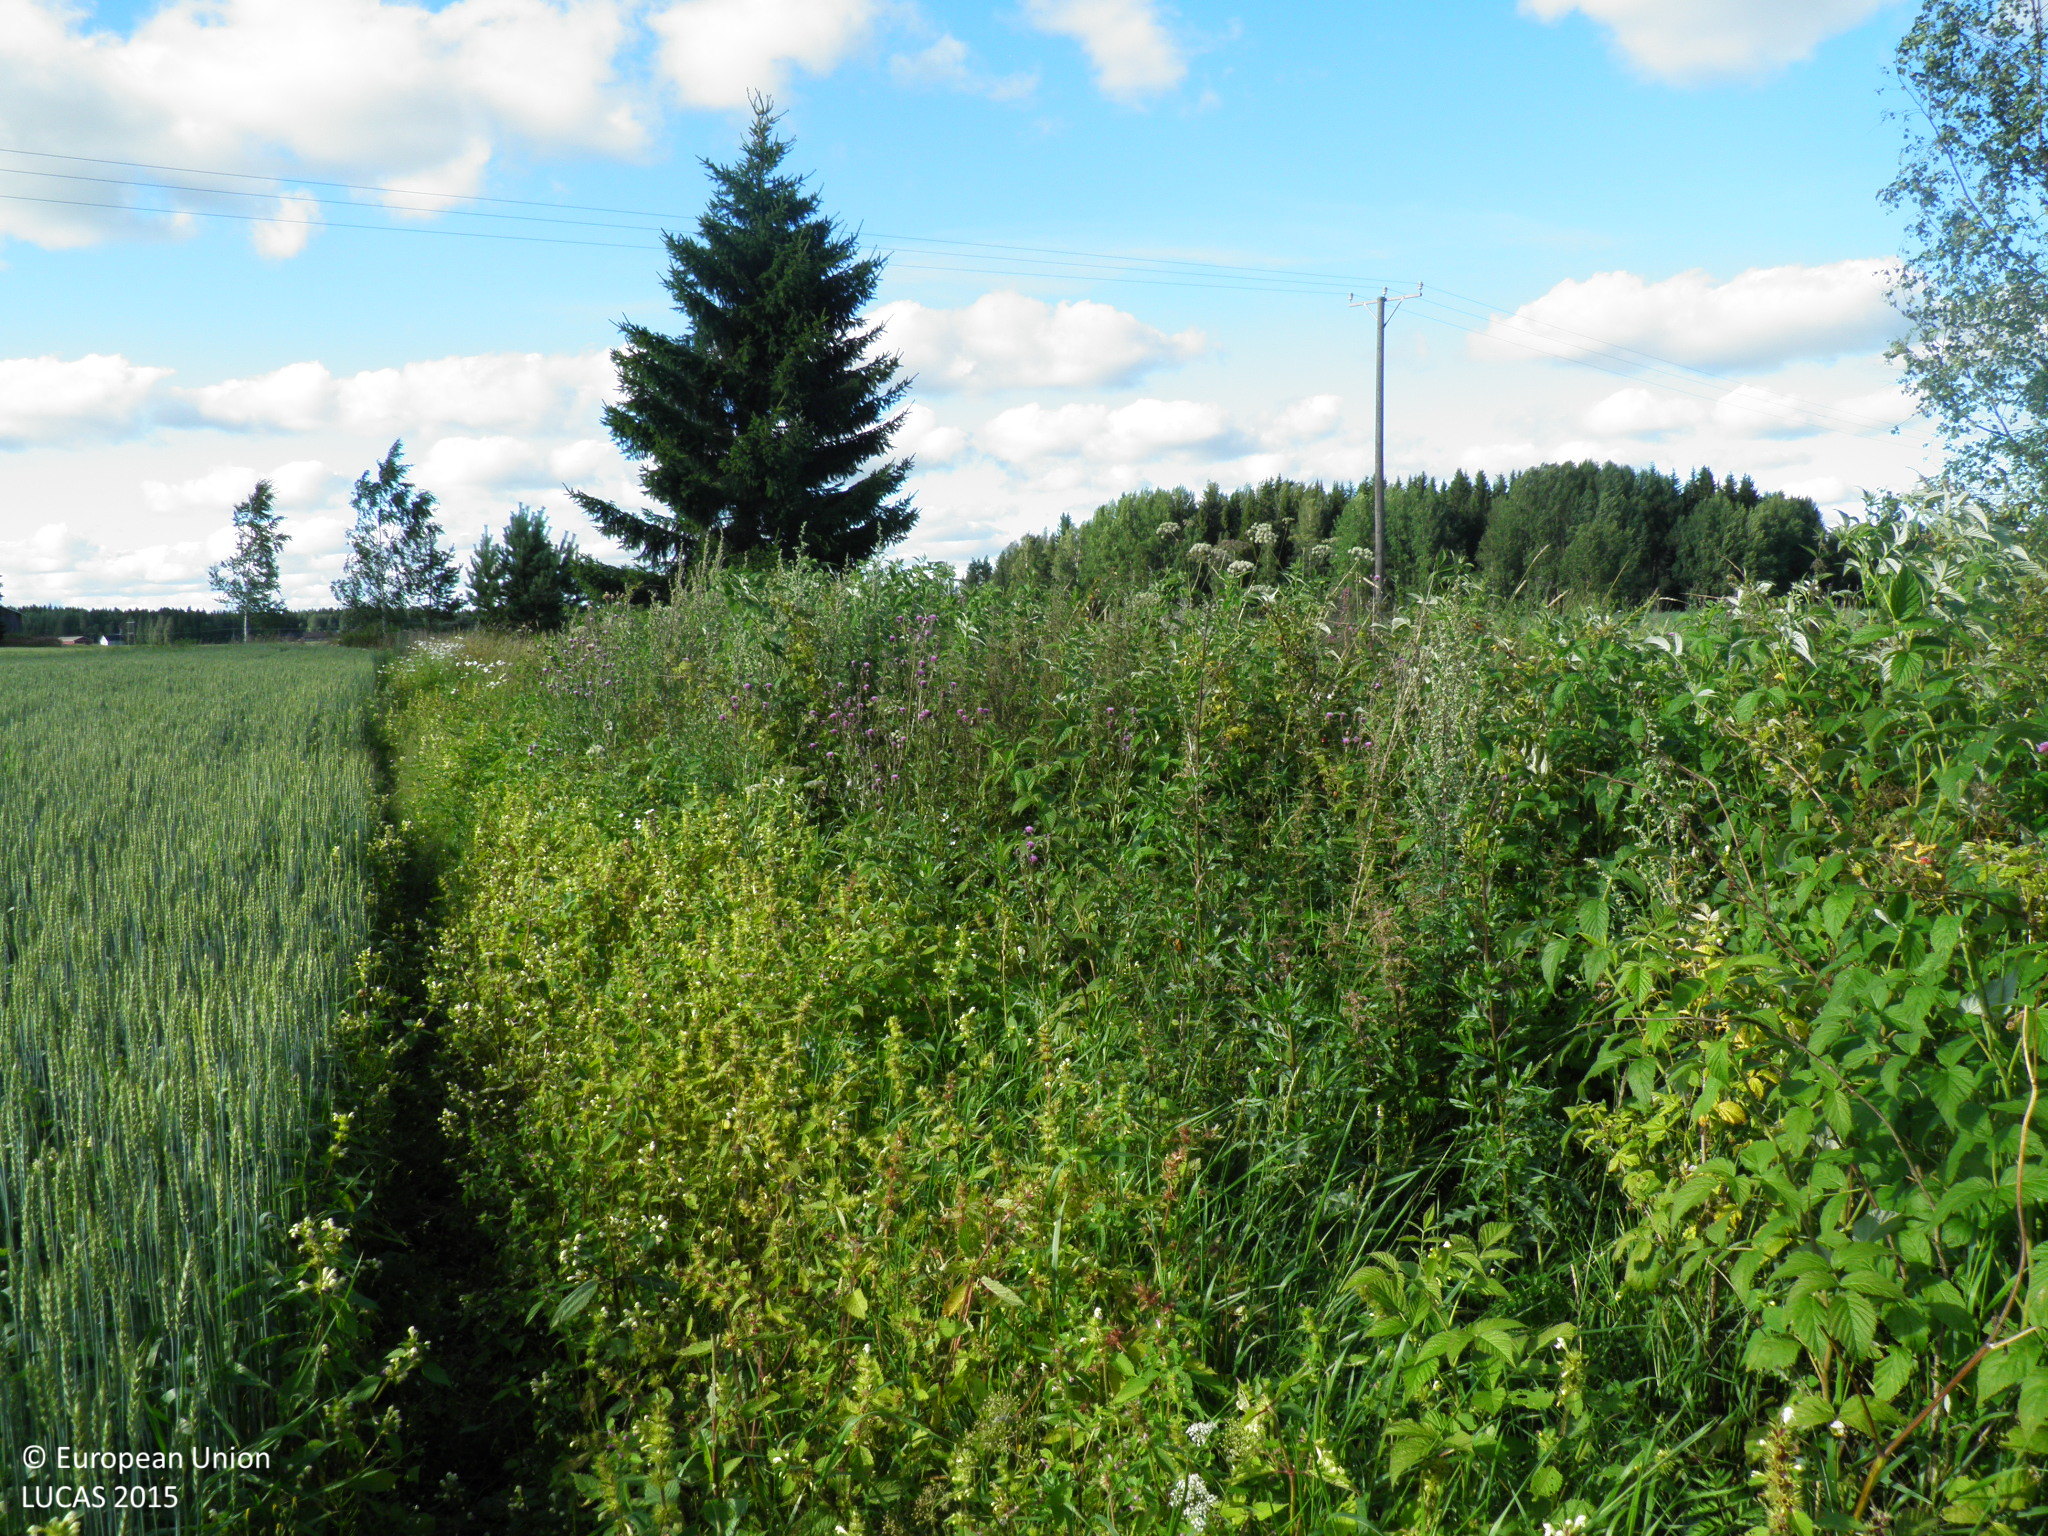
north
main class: Cropland
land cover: Common wheat
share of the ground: > 75 %
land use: Agriculture (excluding fallow land and kitchen gardens)
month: August
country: FI
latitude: 61.0022
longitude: 23.0006
